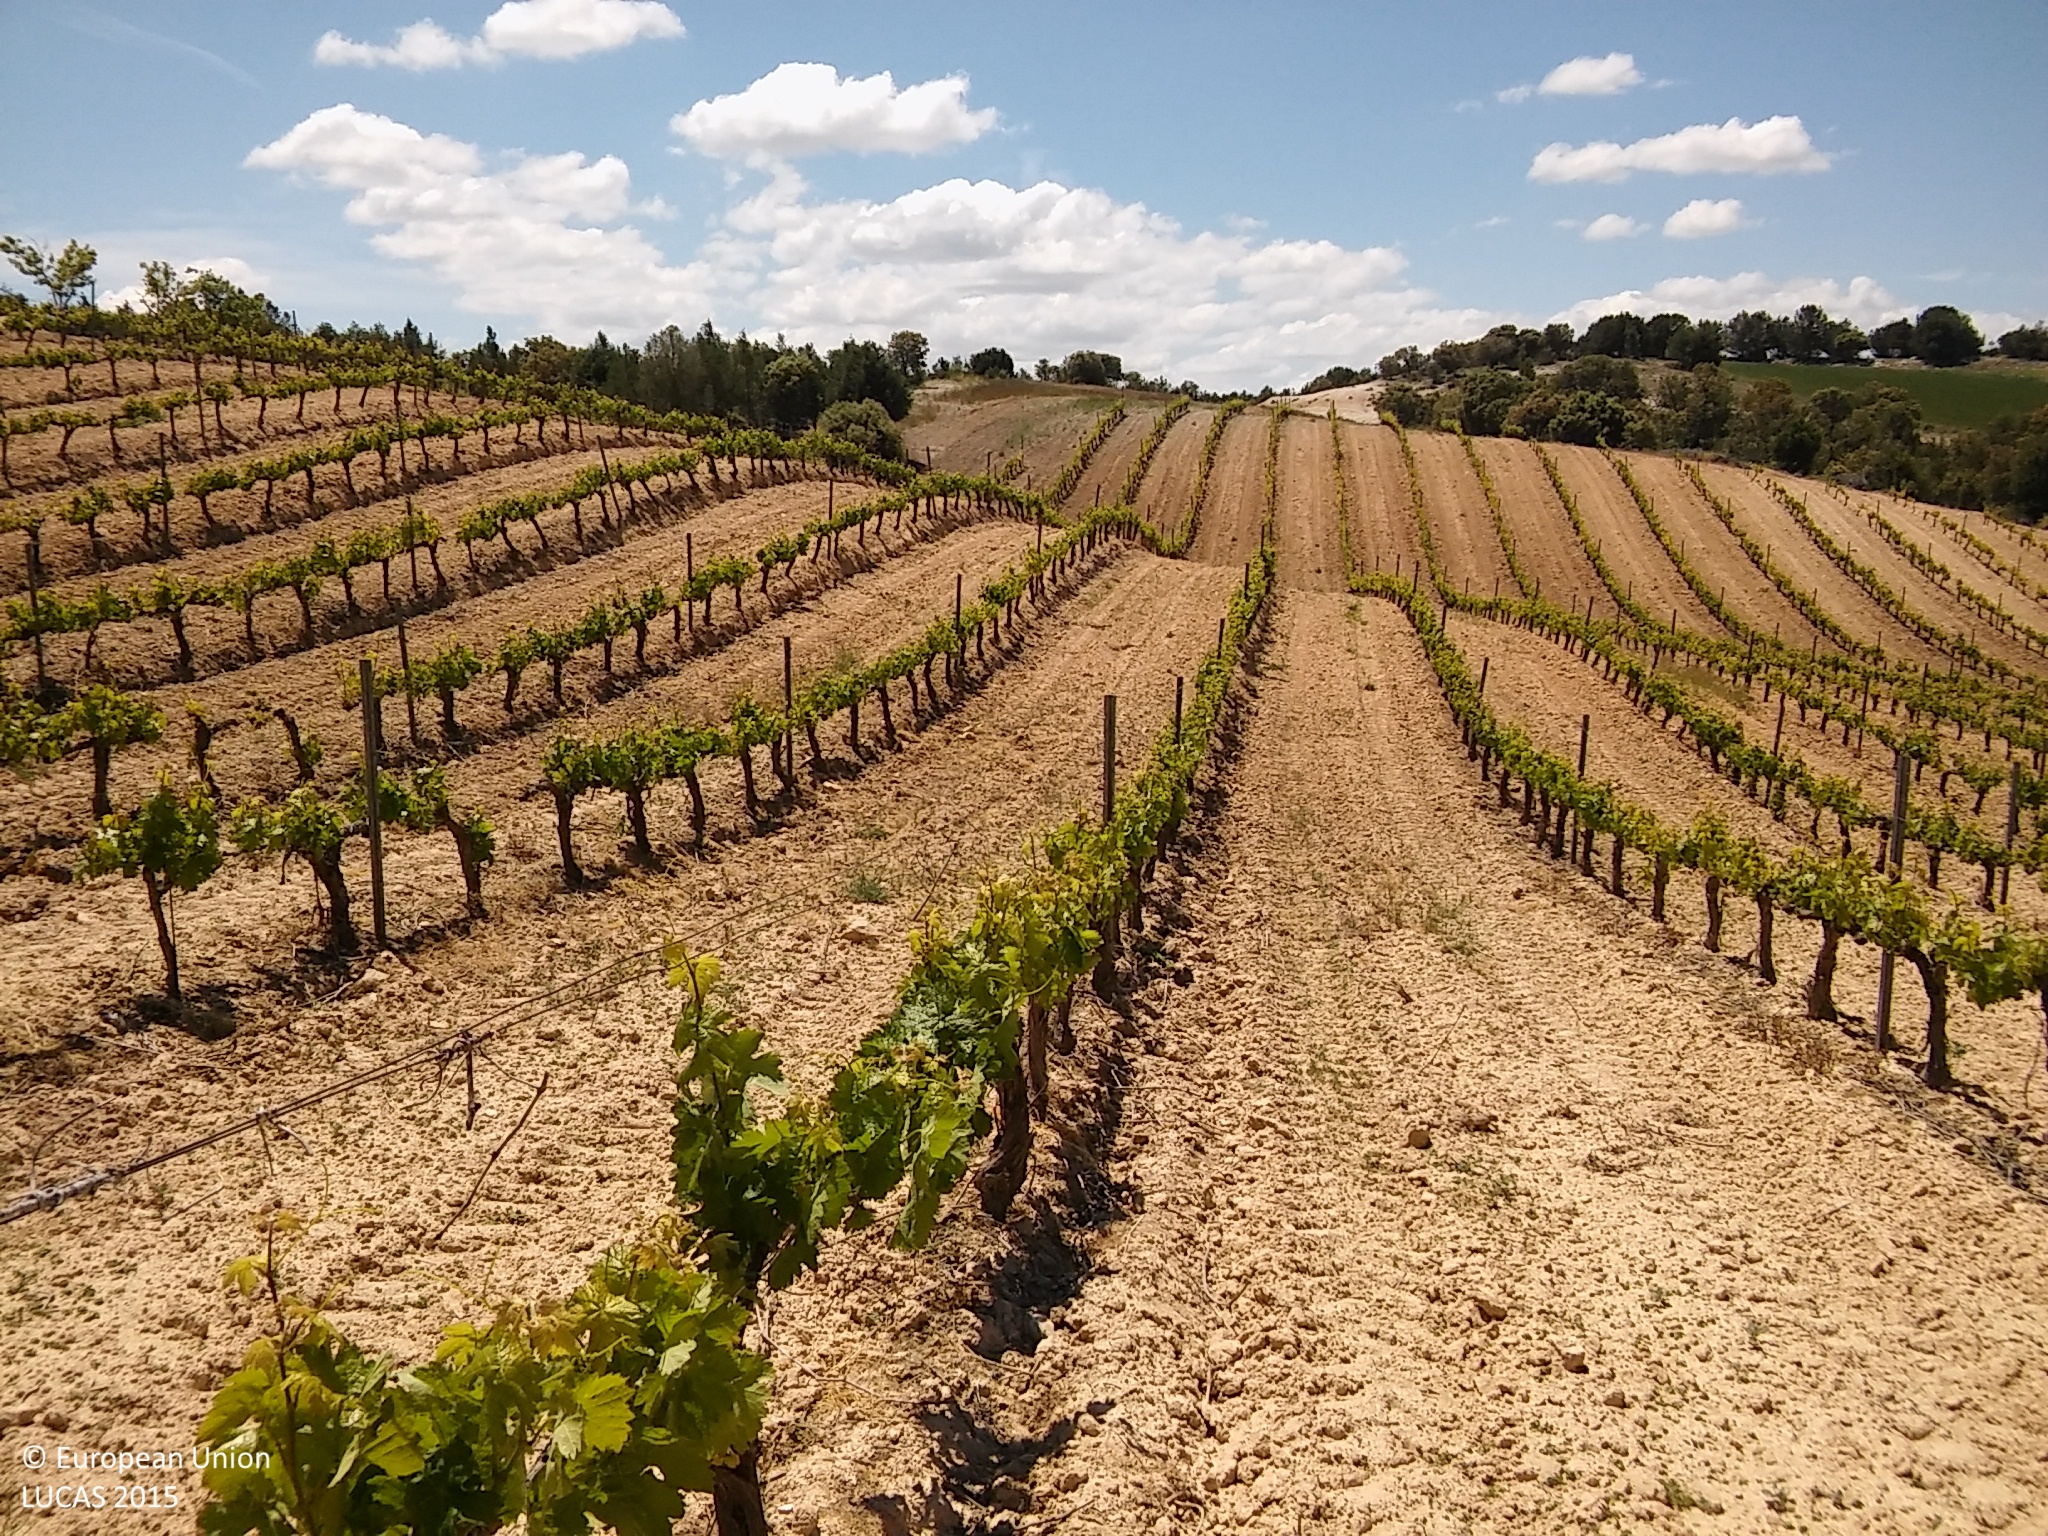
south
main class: Cropland
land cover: Vineyards
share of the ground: 10 - 25 %
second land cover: Other bare soil
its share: > 75 %
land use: Agriculture (excluding fallow land and kitchen gardens)
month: May
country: ES
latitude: 41.6188
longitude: -3.6249
